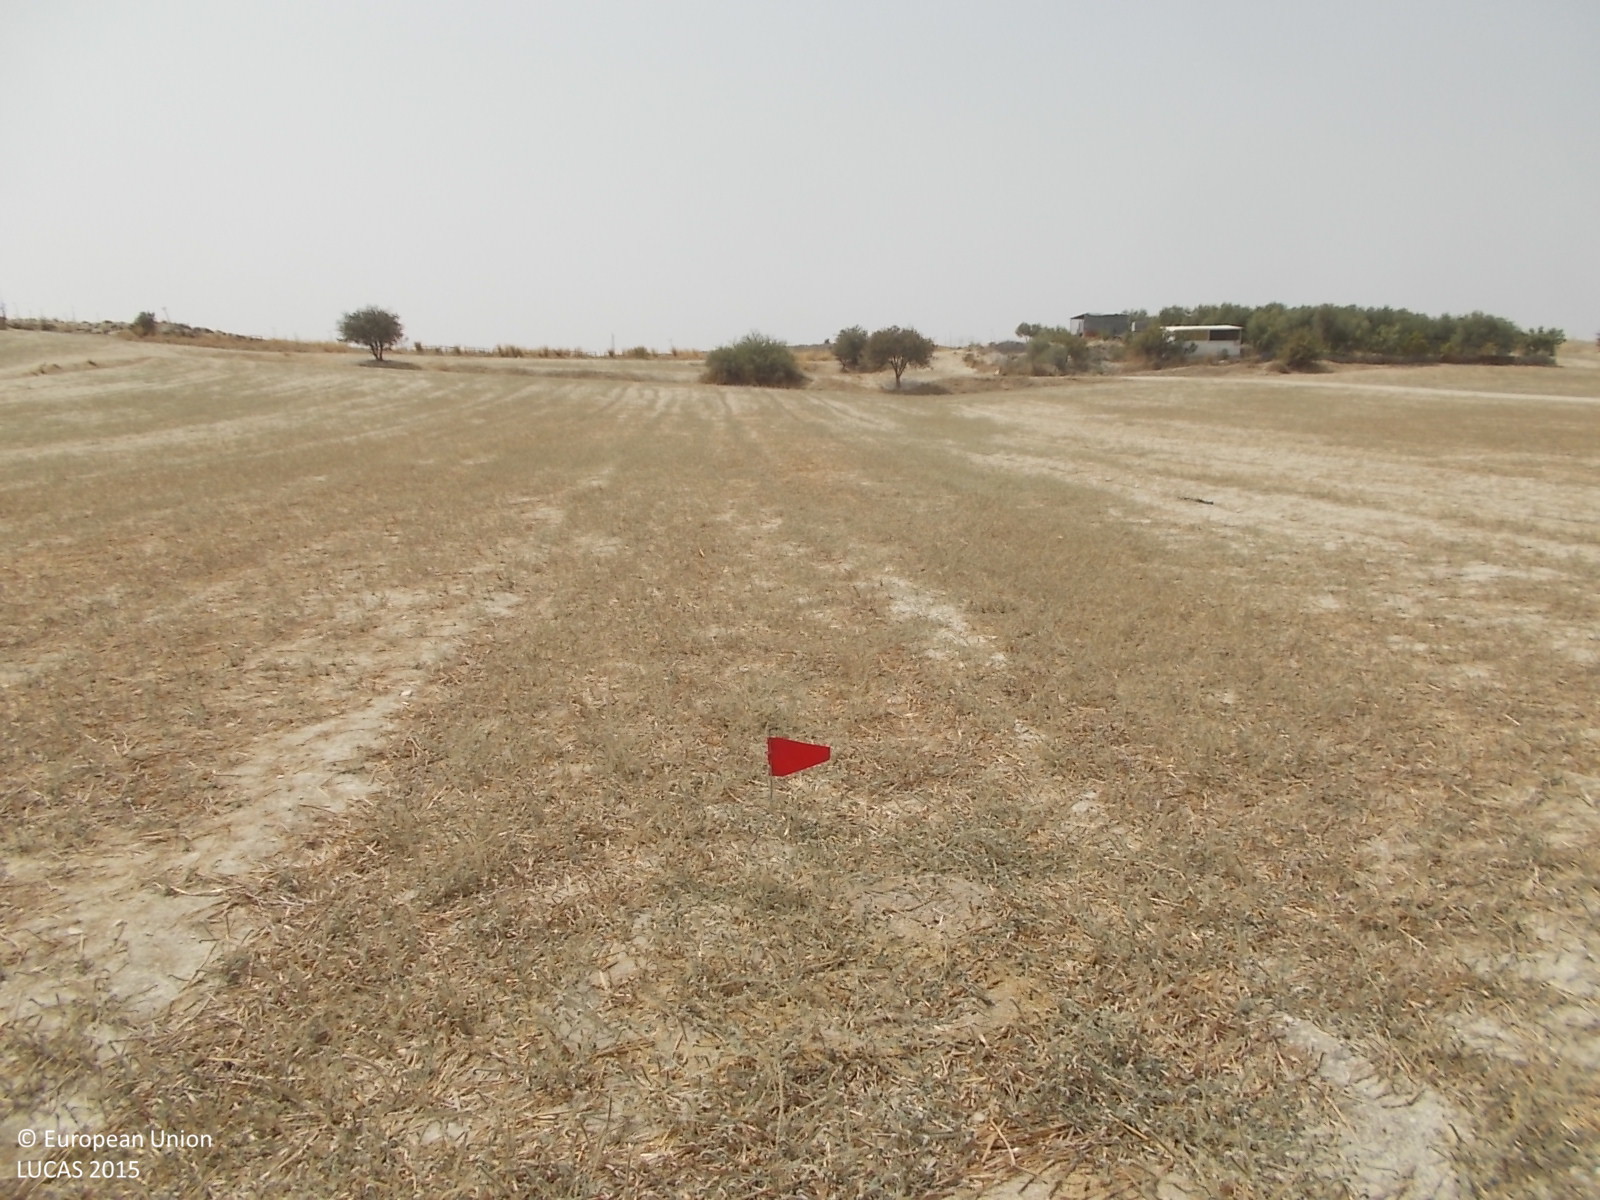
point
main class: Cropland
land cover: Mixed cereals for fodder
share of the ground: > 75 %
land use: Agriculture (excluding fallow land and kitchen gardens)
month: April
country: CY
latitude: 34.9398
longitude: 33.5247
